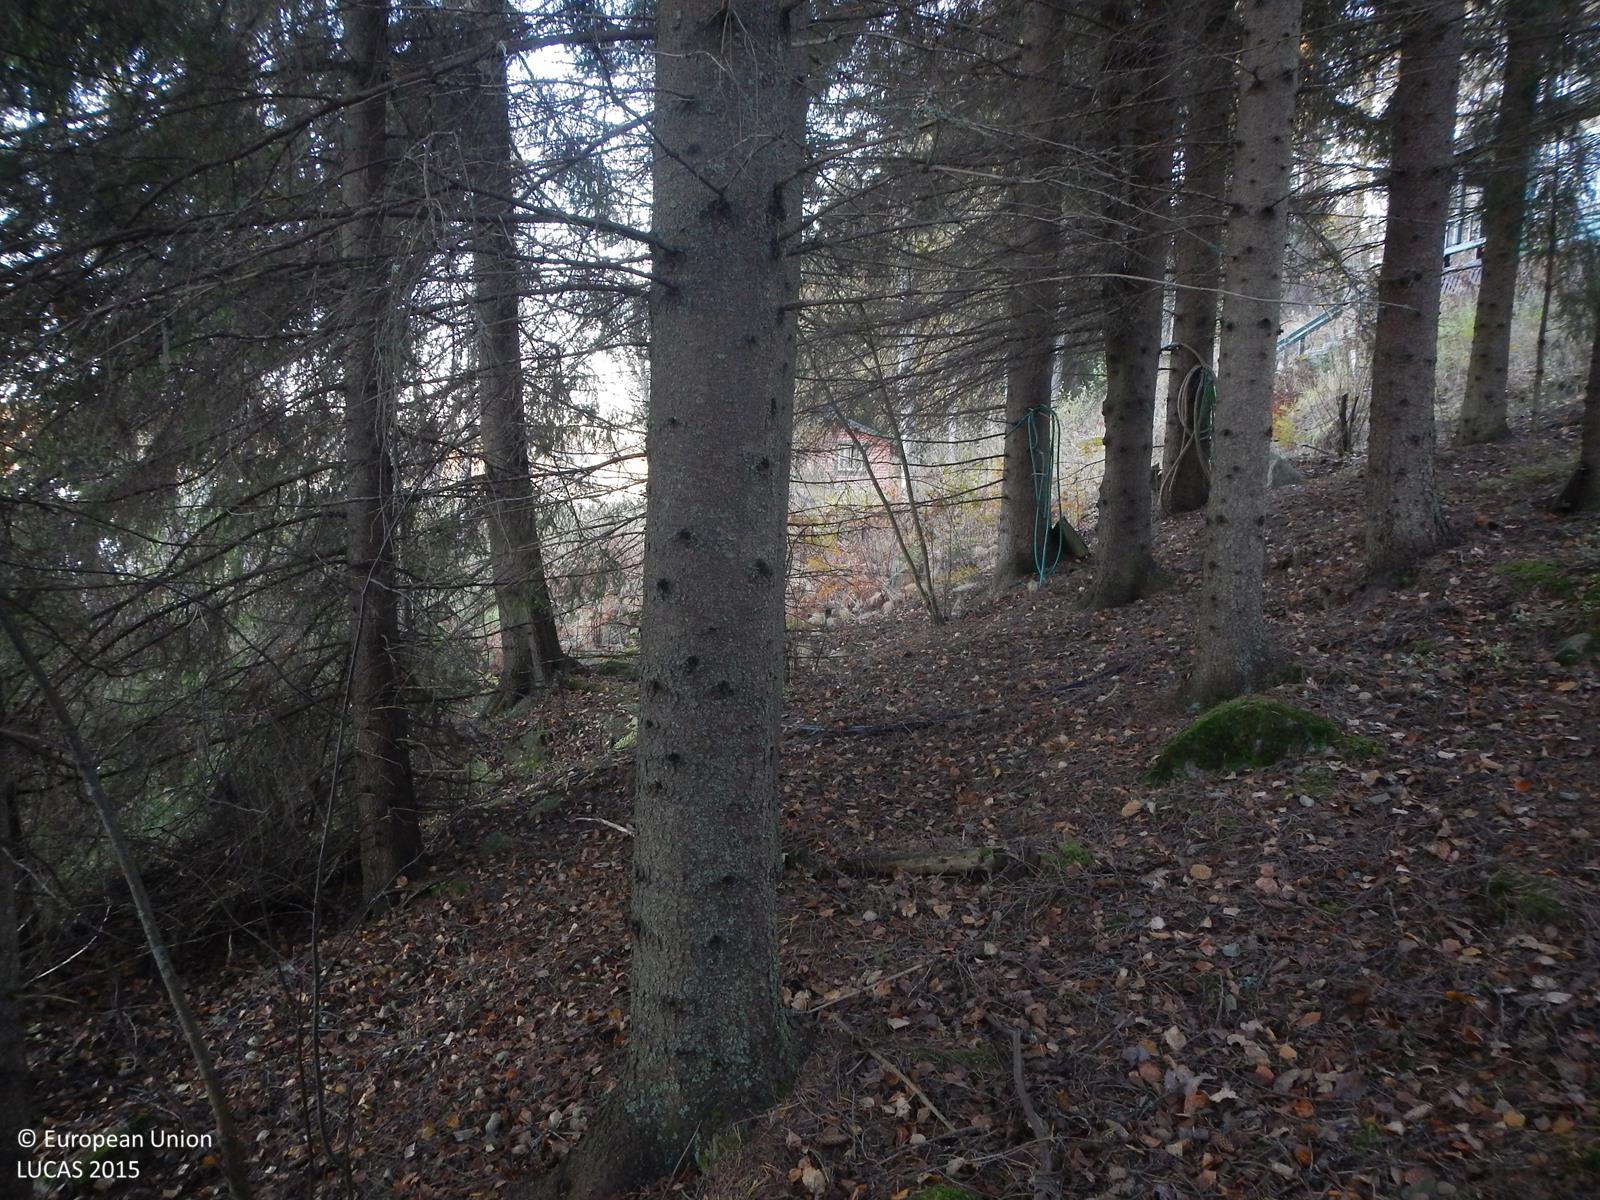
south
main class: Woodland
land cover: Spruce dominated coniferous woodland
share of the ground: > 75 %
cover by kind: coniferous forest trees 90 %, lichens and mosses 5 %, unconsolidated bare surface 5 %
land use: Forestry
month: October
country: FI
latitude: 61.7056
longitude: 25.8822
